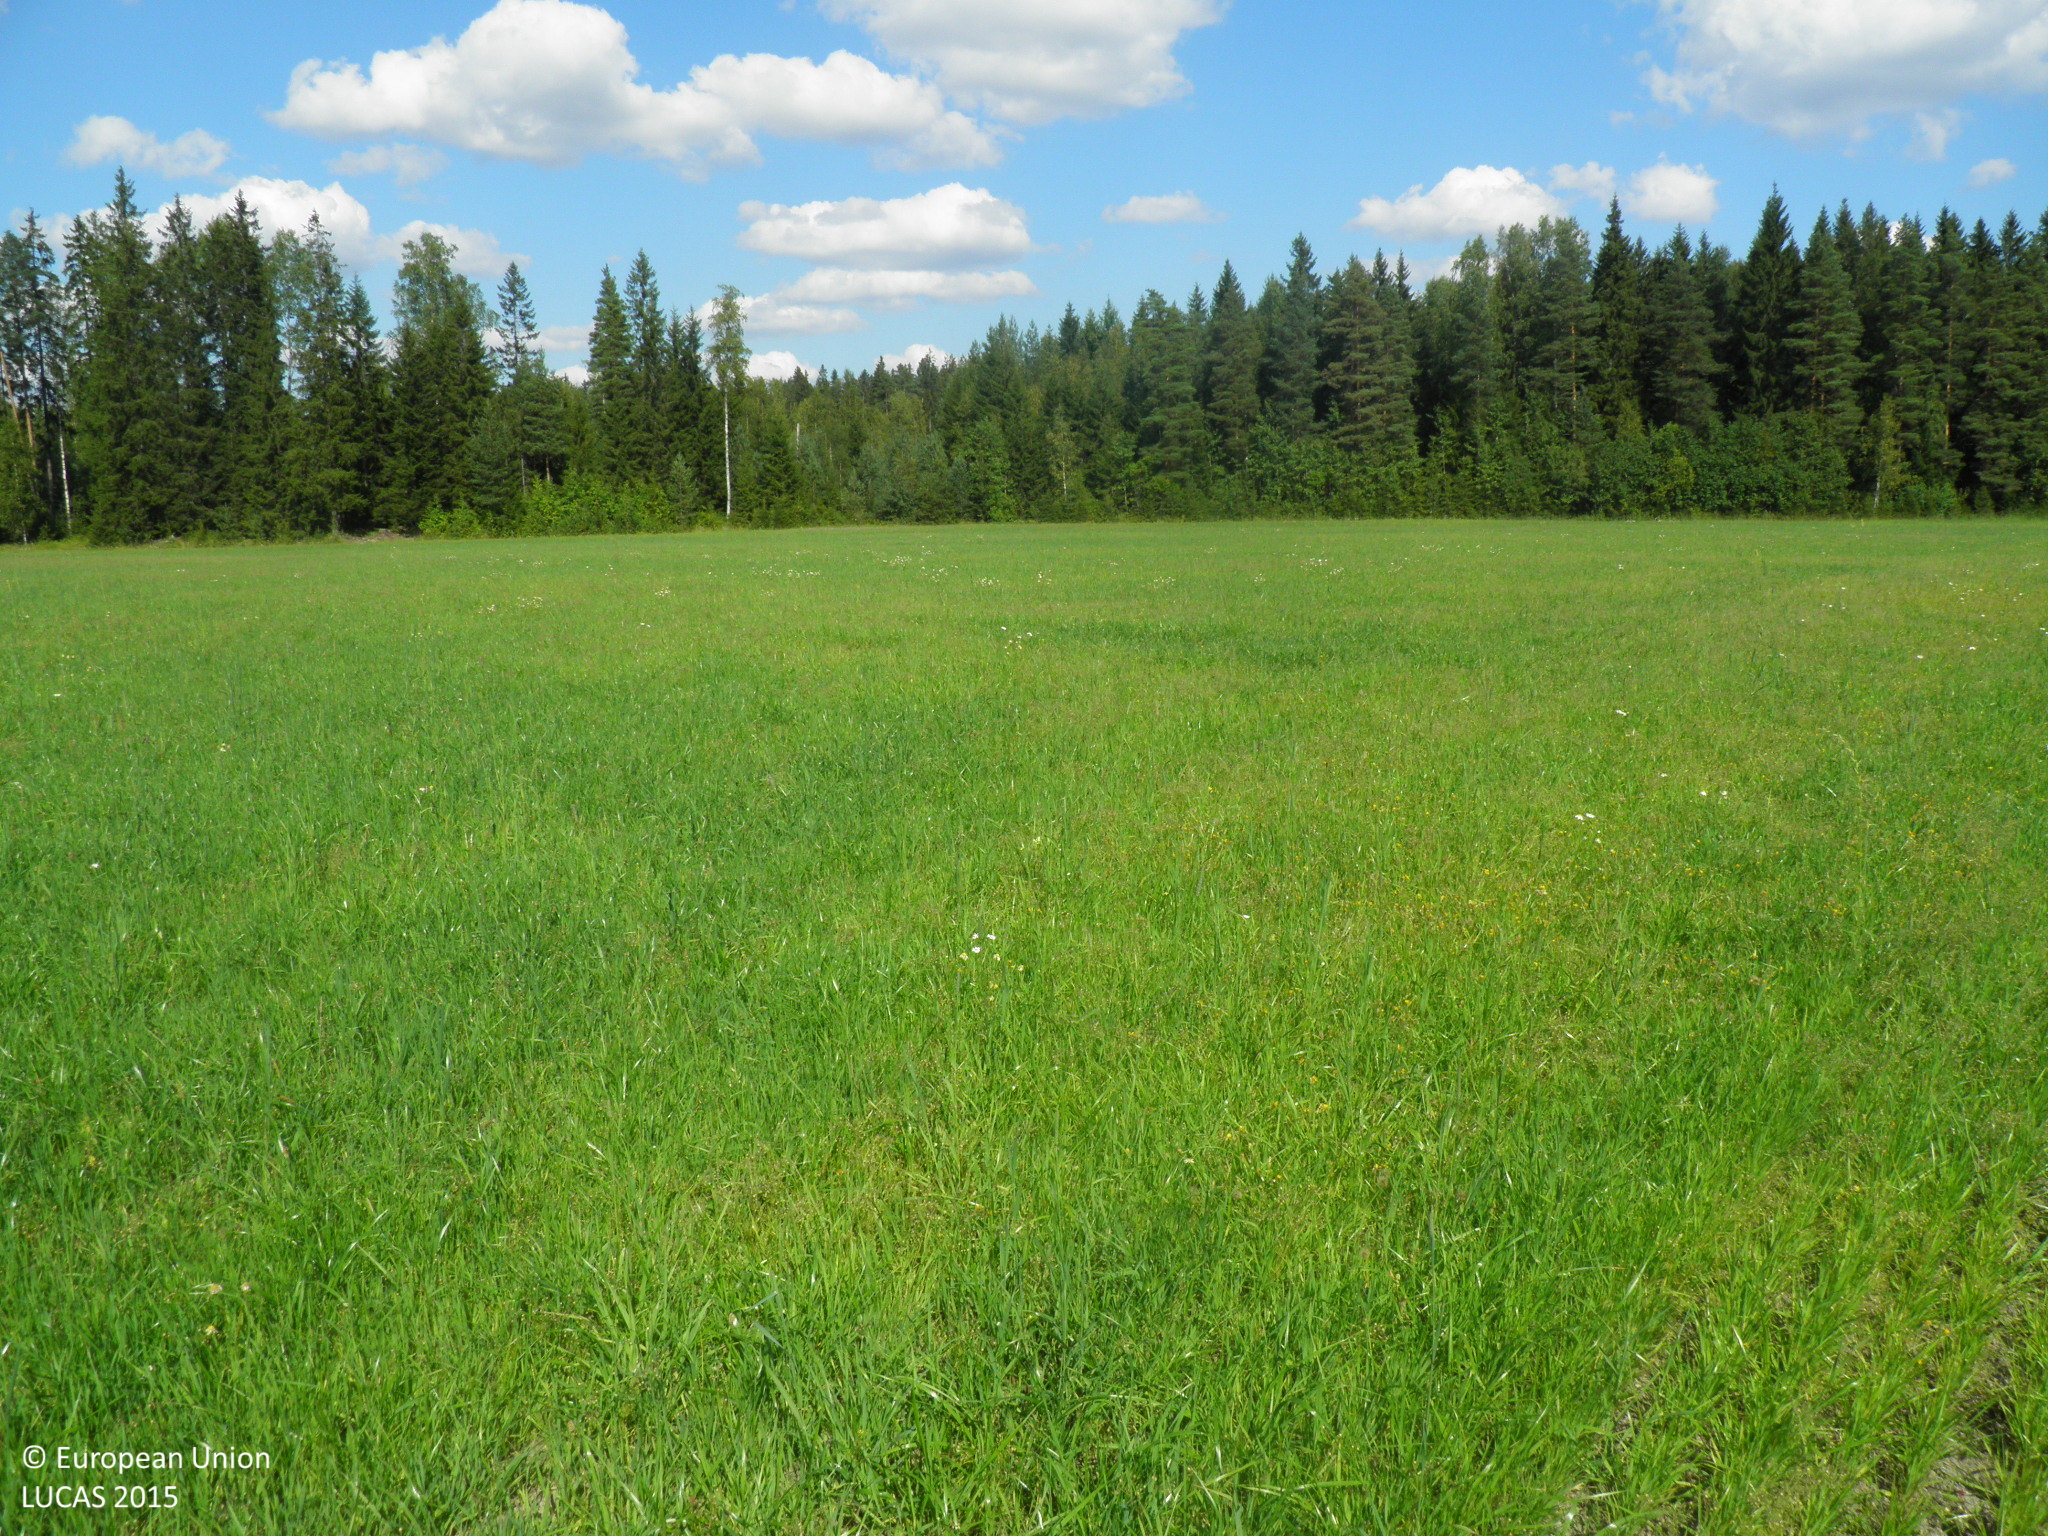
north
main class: Grassland
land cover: Grassland without tree/shrub cover
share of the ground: > 75 %
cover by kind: herbaceous plants 100 %
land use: Agriculture (excluding fallow land and kitchen gardens)
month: August
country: FI
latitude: 60.9878
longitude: 22.9572
